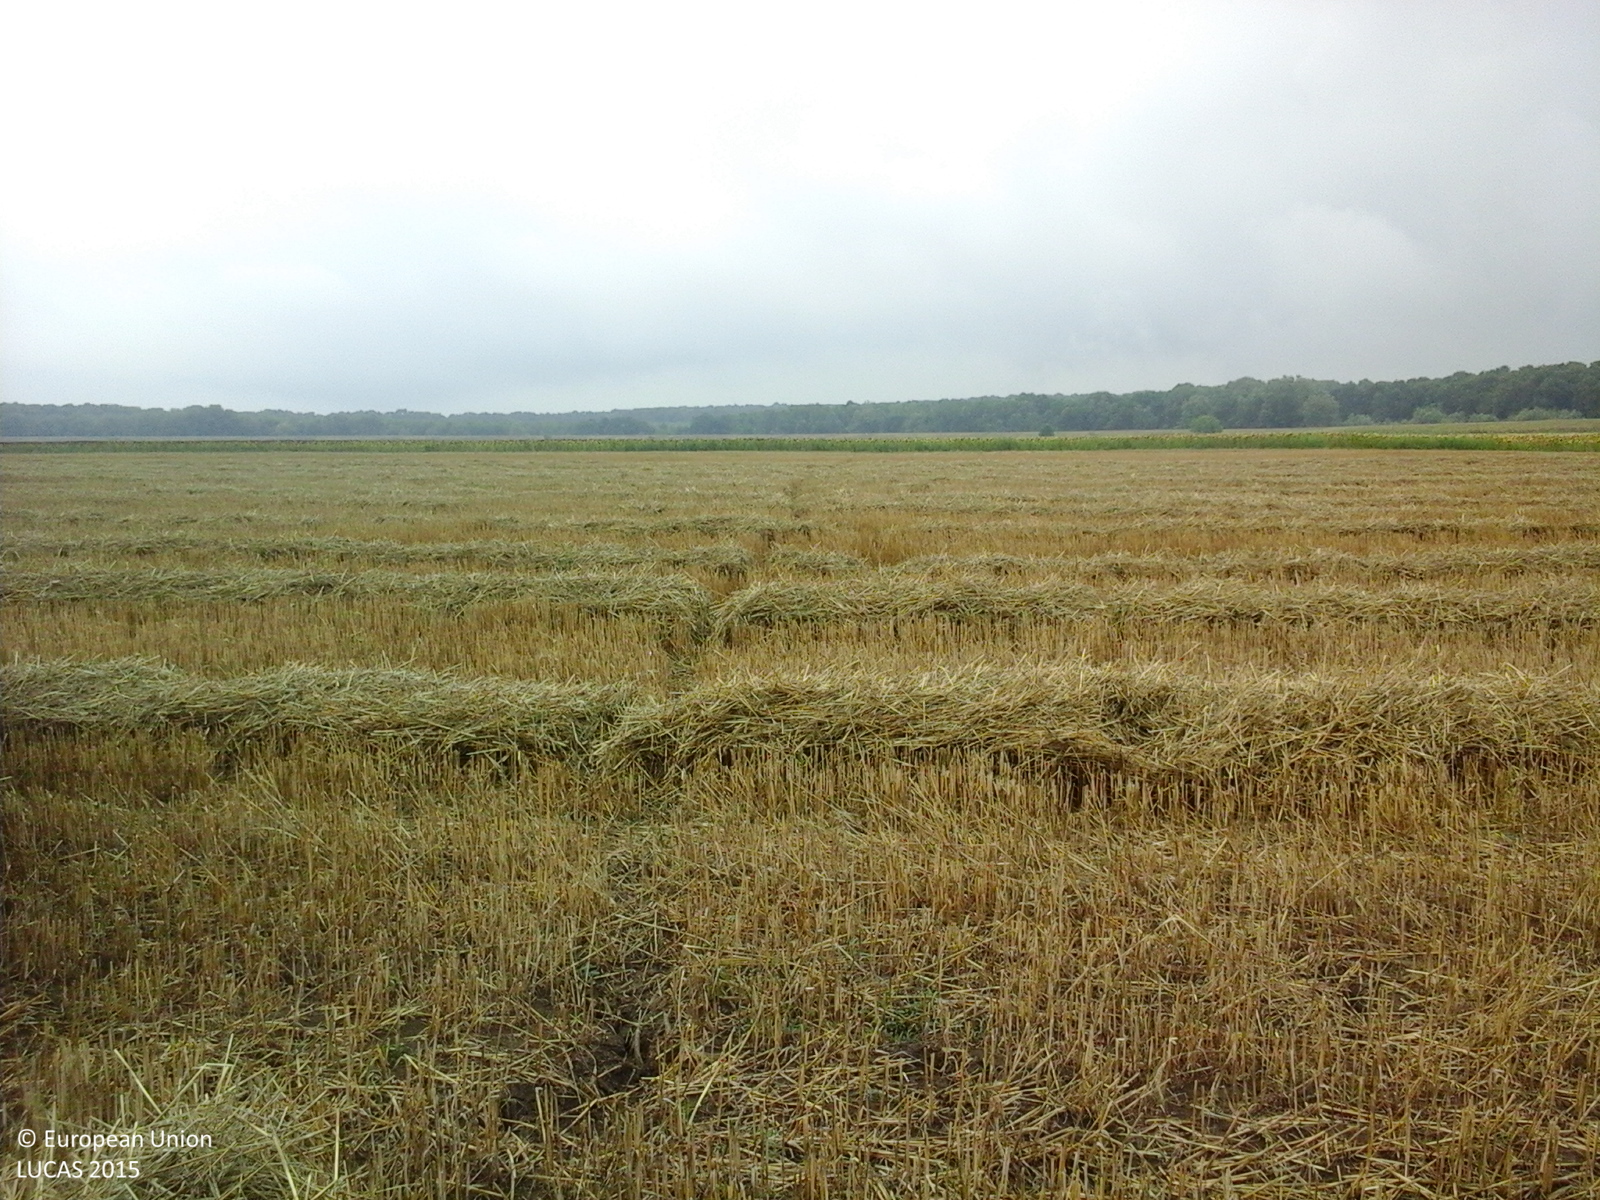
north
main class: Cropland
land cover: Common wheat
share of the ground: < 10 %
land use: Agriculture (excluding fallow land and kitchen gardens)
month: August
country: RO
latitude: 46.1571
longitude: 20.5269
